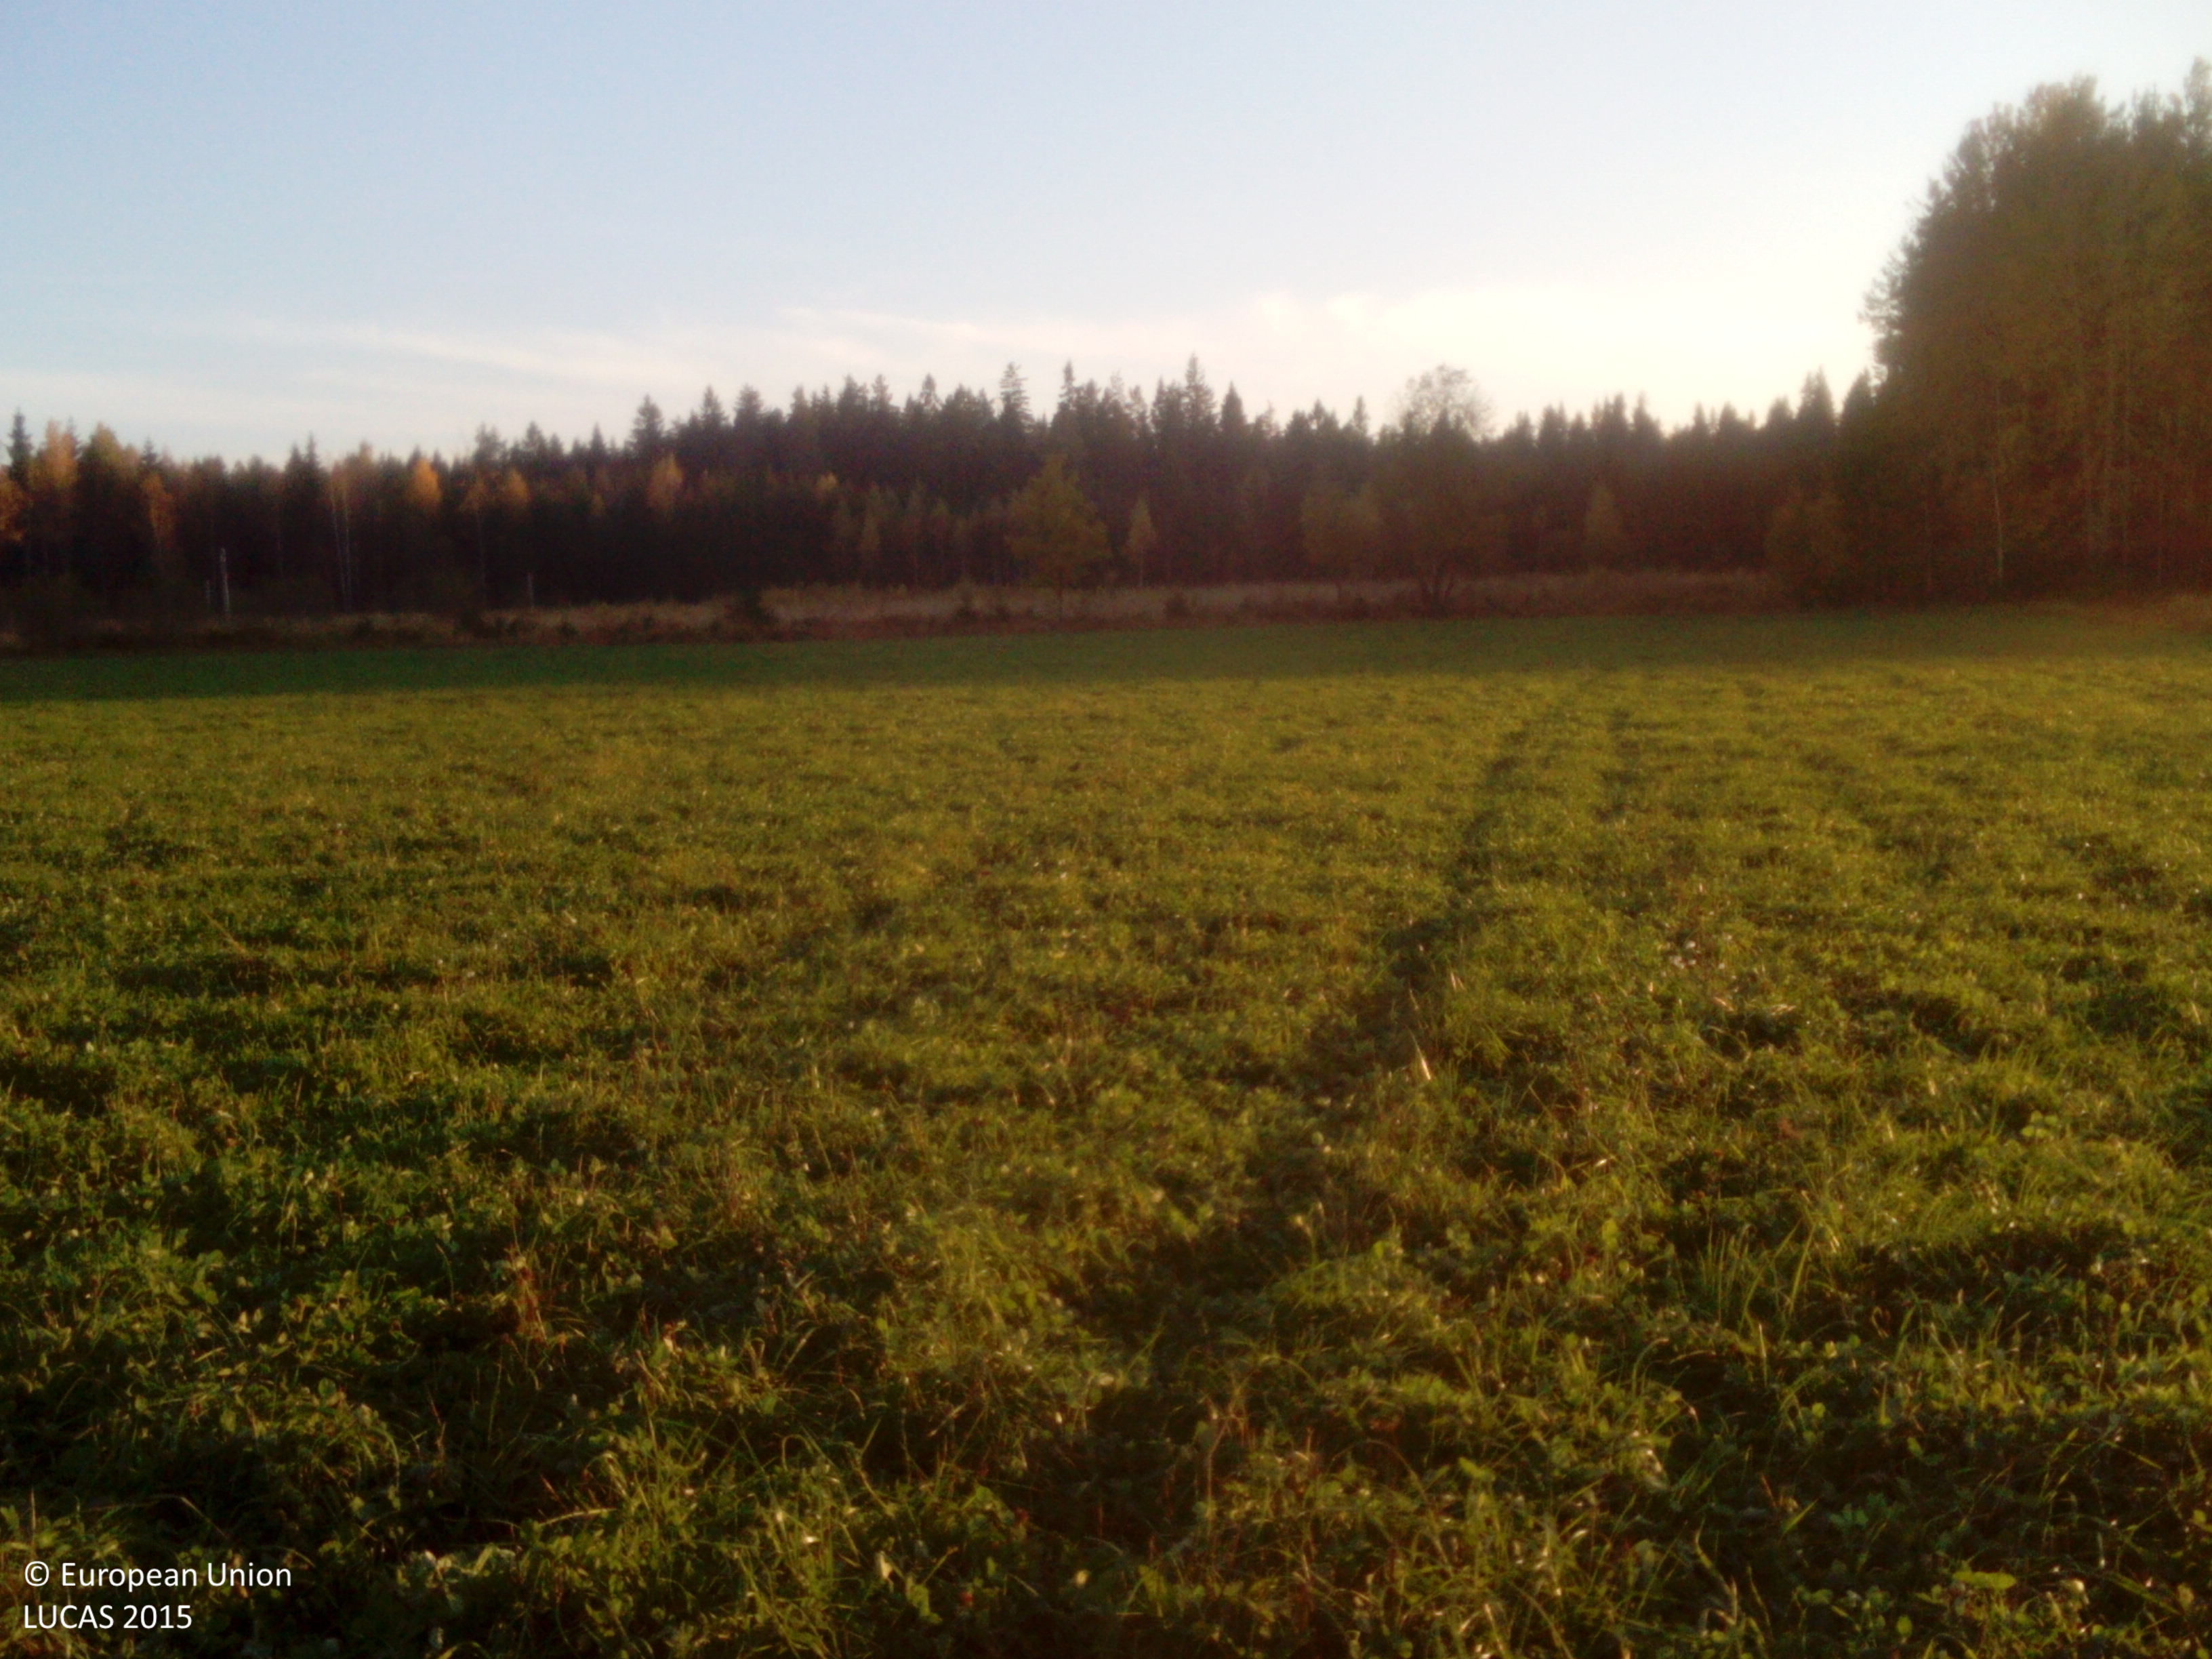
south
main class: Cropland
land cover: Clovers
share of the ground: > 75 %
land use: Agriculture (excluding fallow land and kitchen gardens)
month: October
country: SE
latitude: 58.8797
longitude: 16.3956
